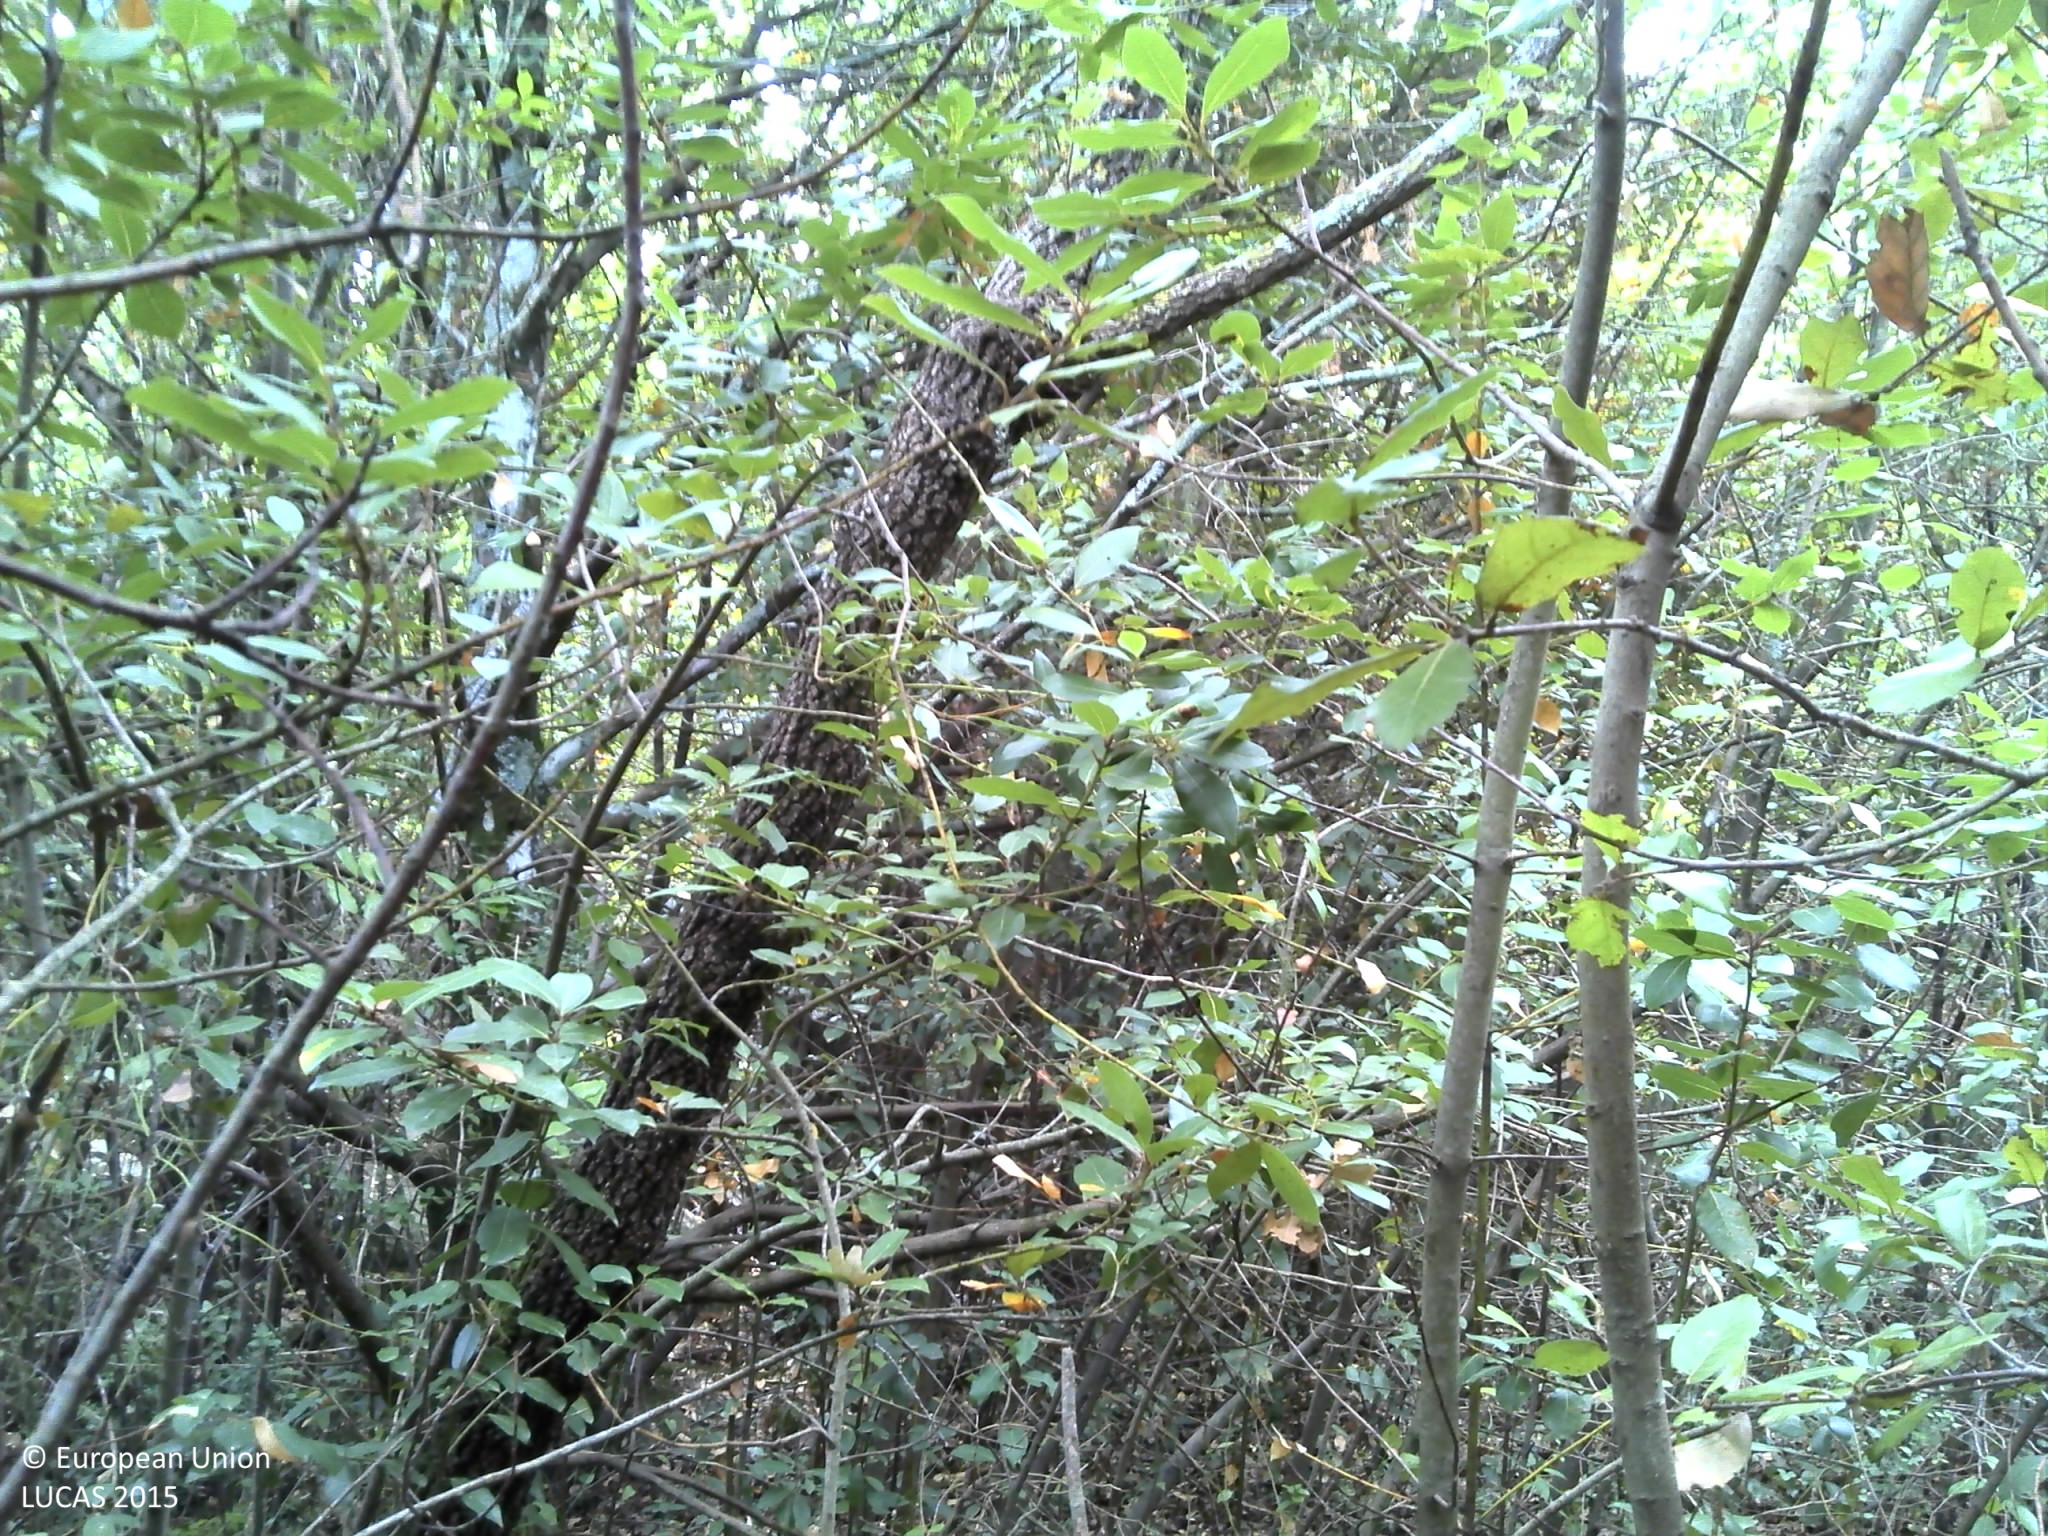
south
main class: Woodland
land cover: Other mixed woodland
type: coniferous forest of the mediterranean region
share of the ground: 25 - 50 %
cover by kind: coniferous forest trees 30 %, herbaceous plants 30 %, broadleaved forest trees 20 %, shrubs 10 %, unconsolidated bare surface 10 %
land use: Semi-natural and natural areas not in use
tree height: > 5 m
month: July
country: HR
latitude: 42.7625
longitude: 17.8964
